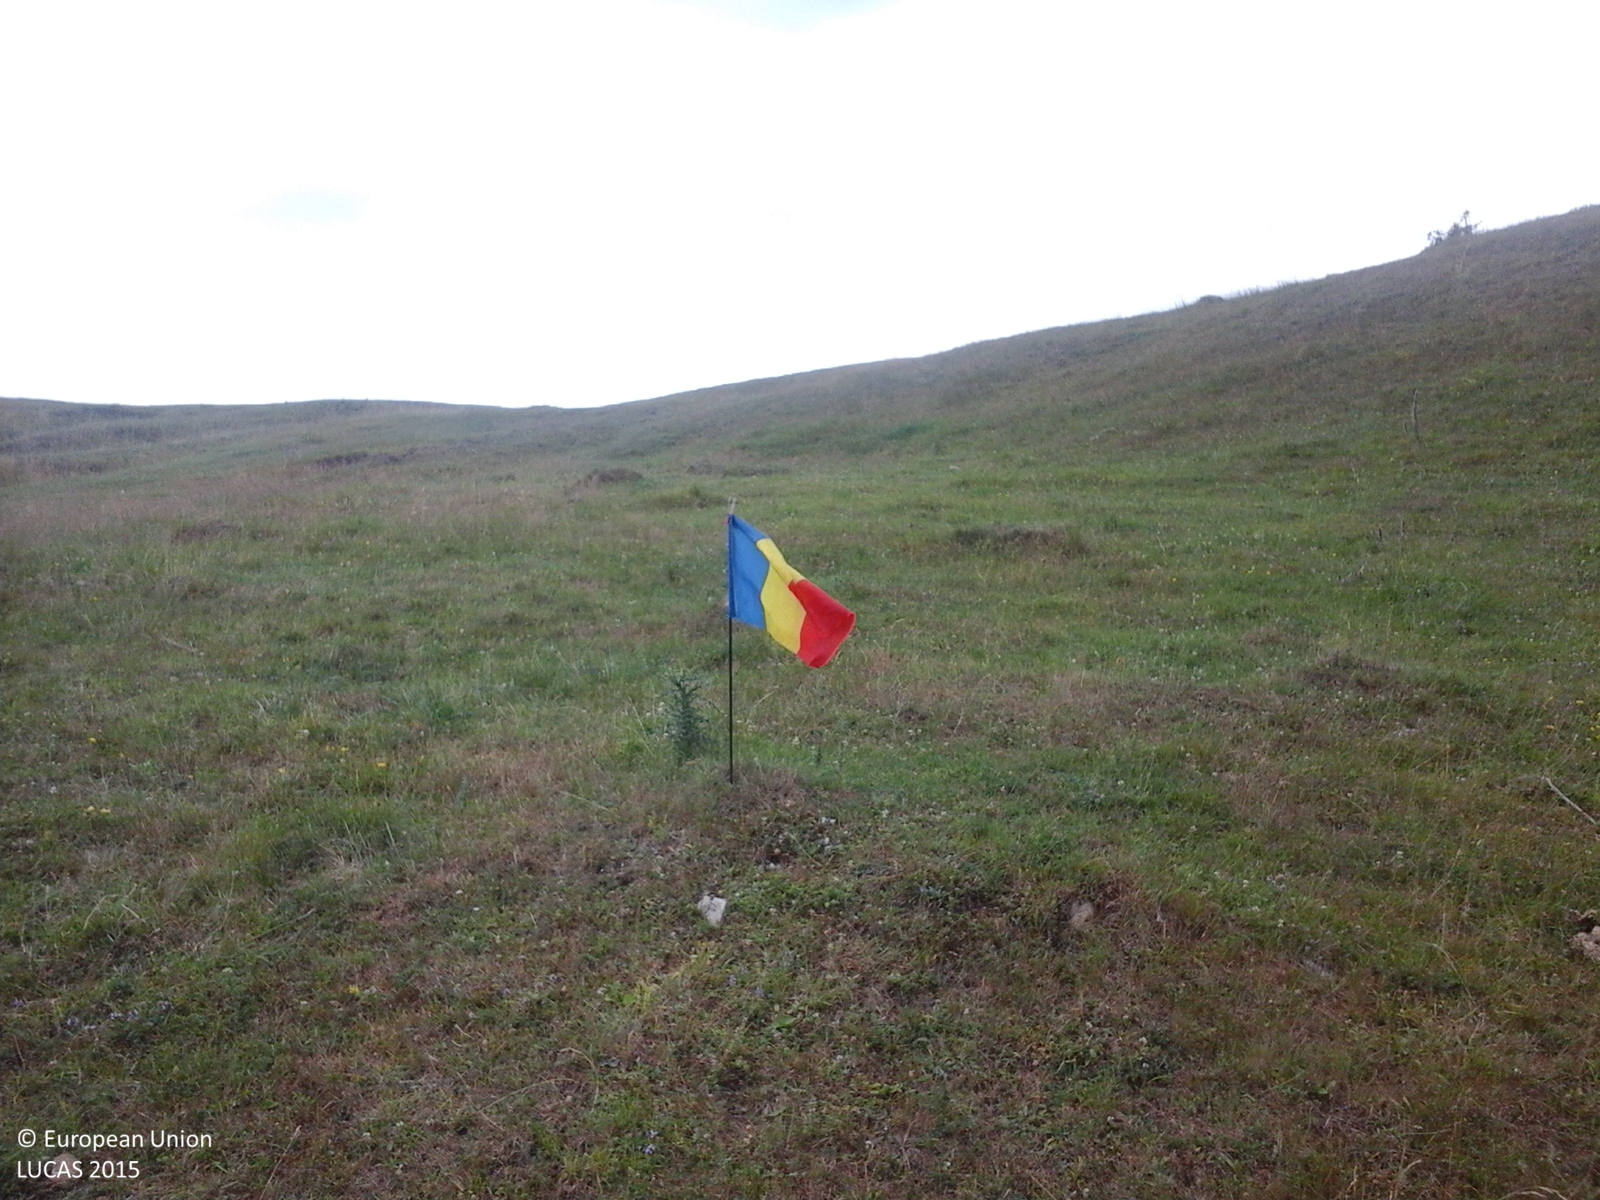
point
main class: Grassland
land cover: Grassland without tree/shrub cover
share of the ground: > 75 %
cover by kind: herbaceous plants 100 %
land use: Agriculture (excluding fallow land and kitchen gardens)
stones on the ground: < 10 %
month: July
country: RO
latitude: 45.2806
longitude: 24.6520
